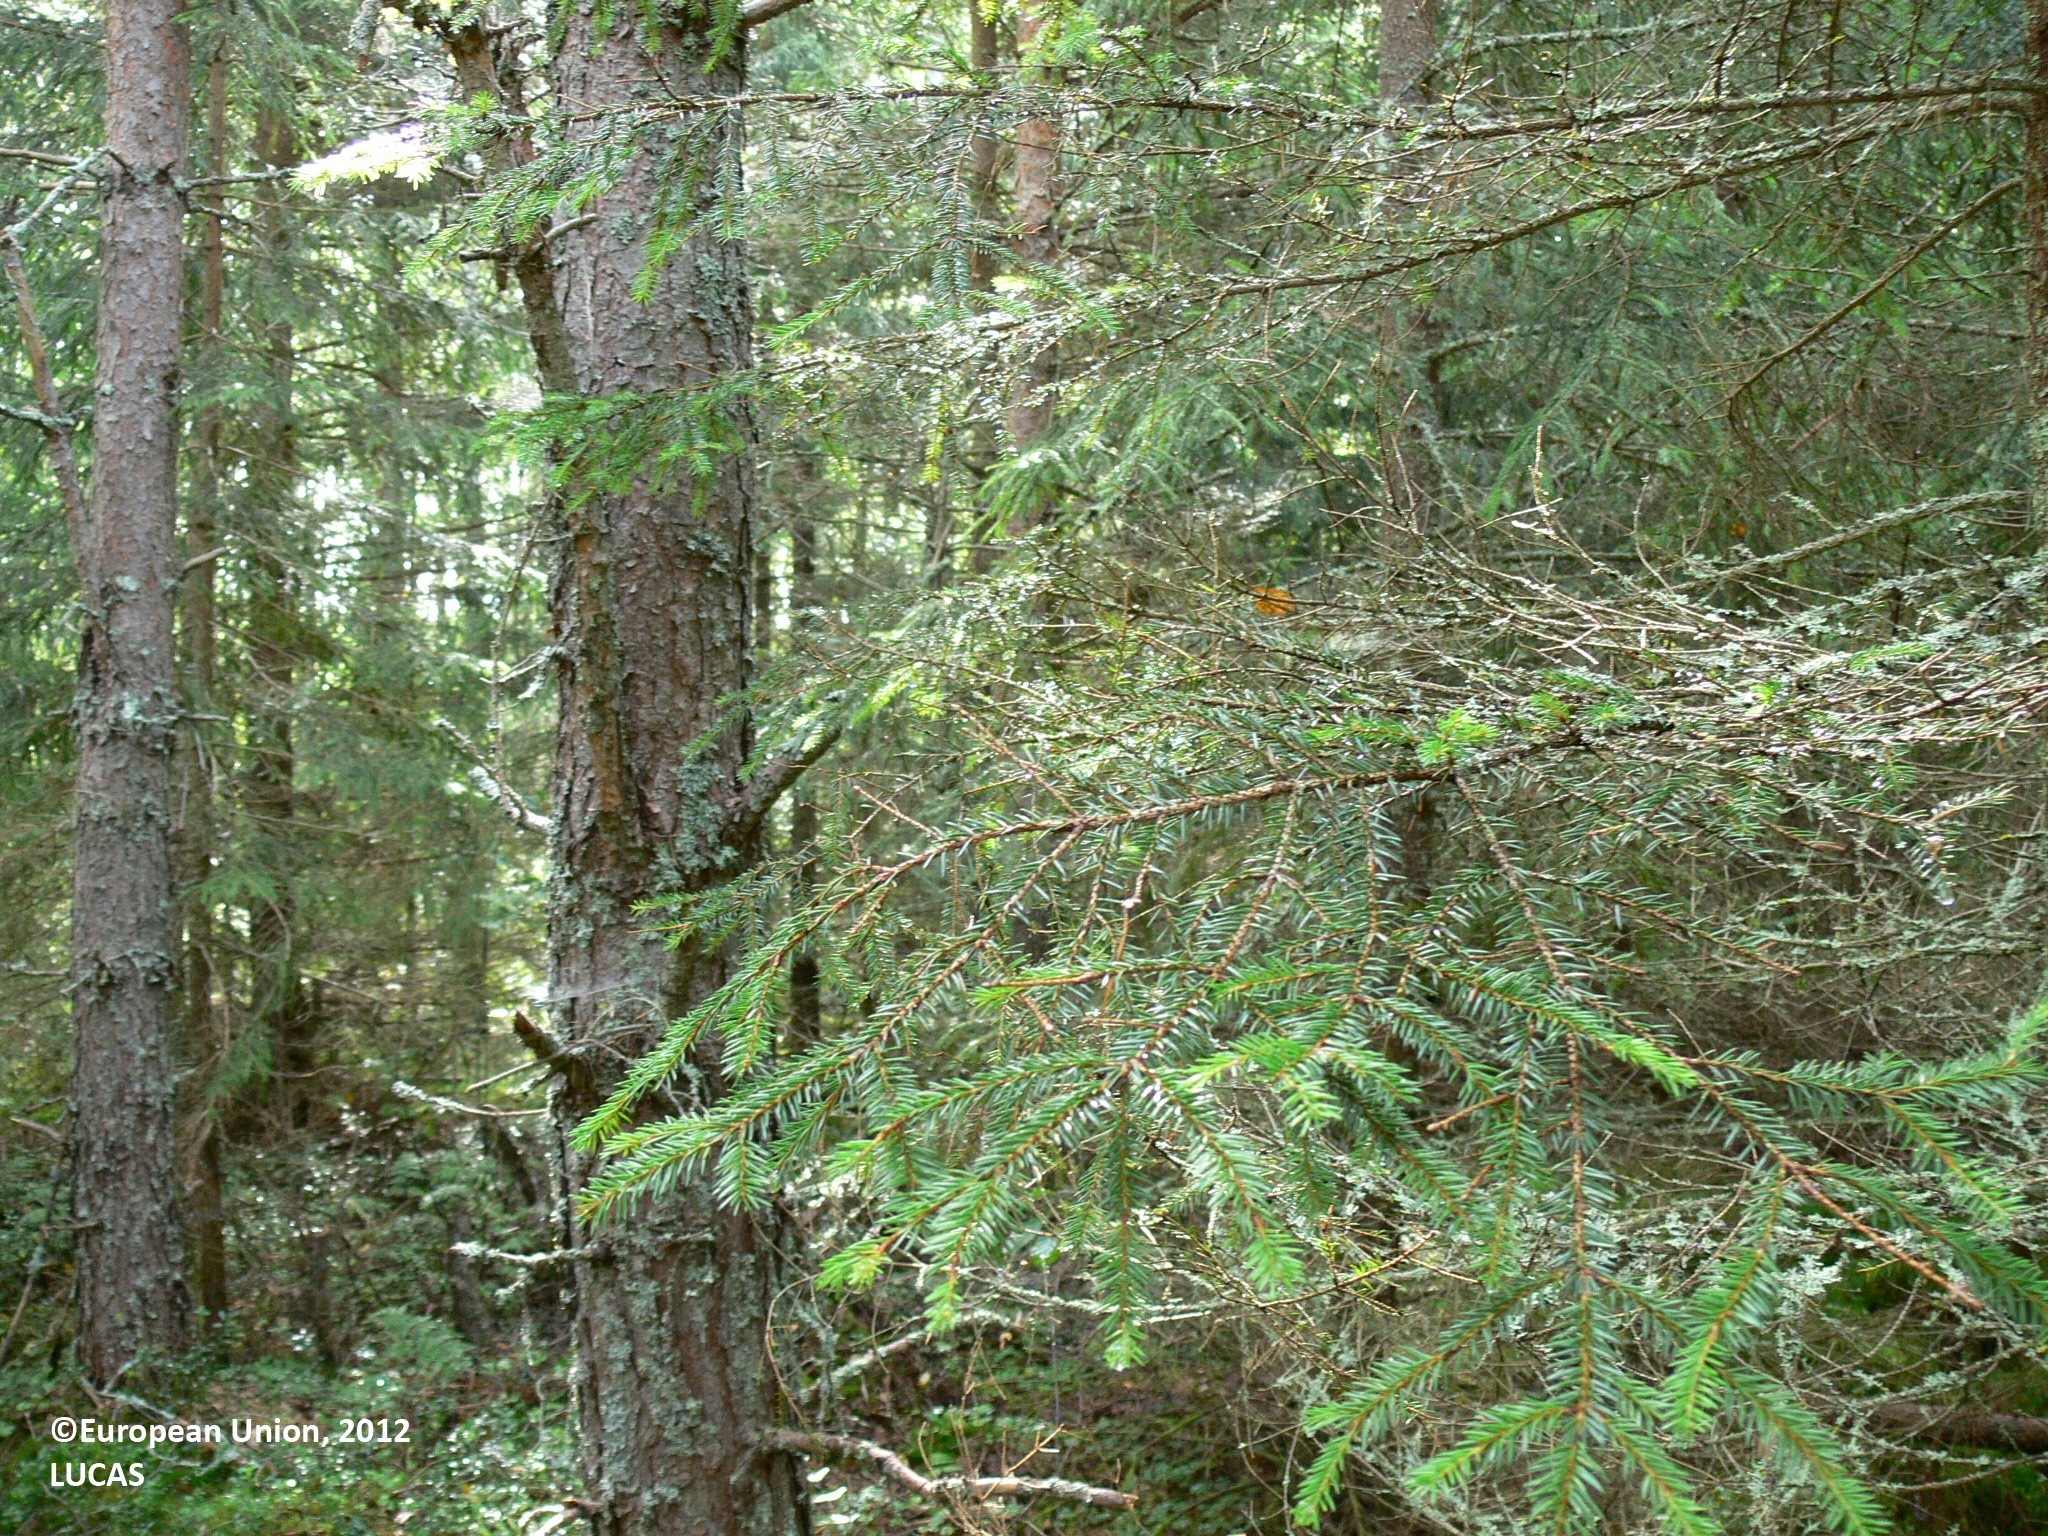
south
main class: Woodland
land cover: Other coniferous woodland
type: boreal forest
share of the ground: > 75 %
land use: Forestry
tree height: > 5 m
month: August
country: FI
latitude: 61.7170
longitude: 29.8434
